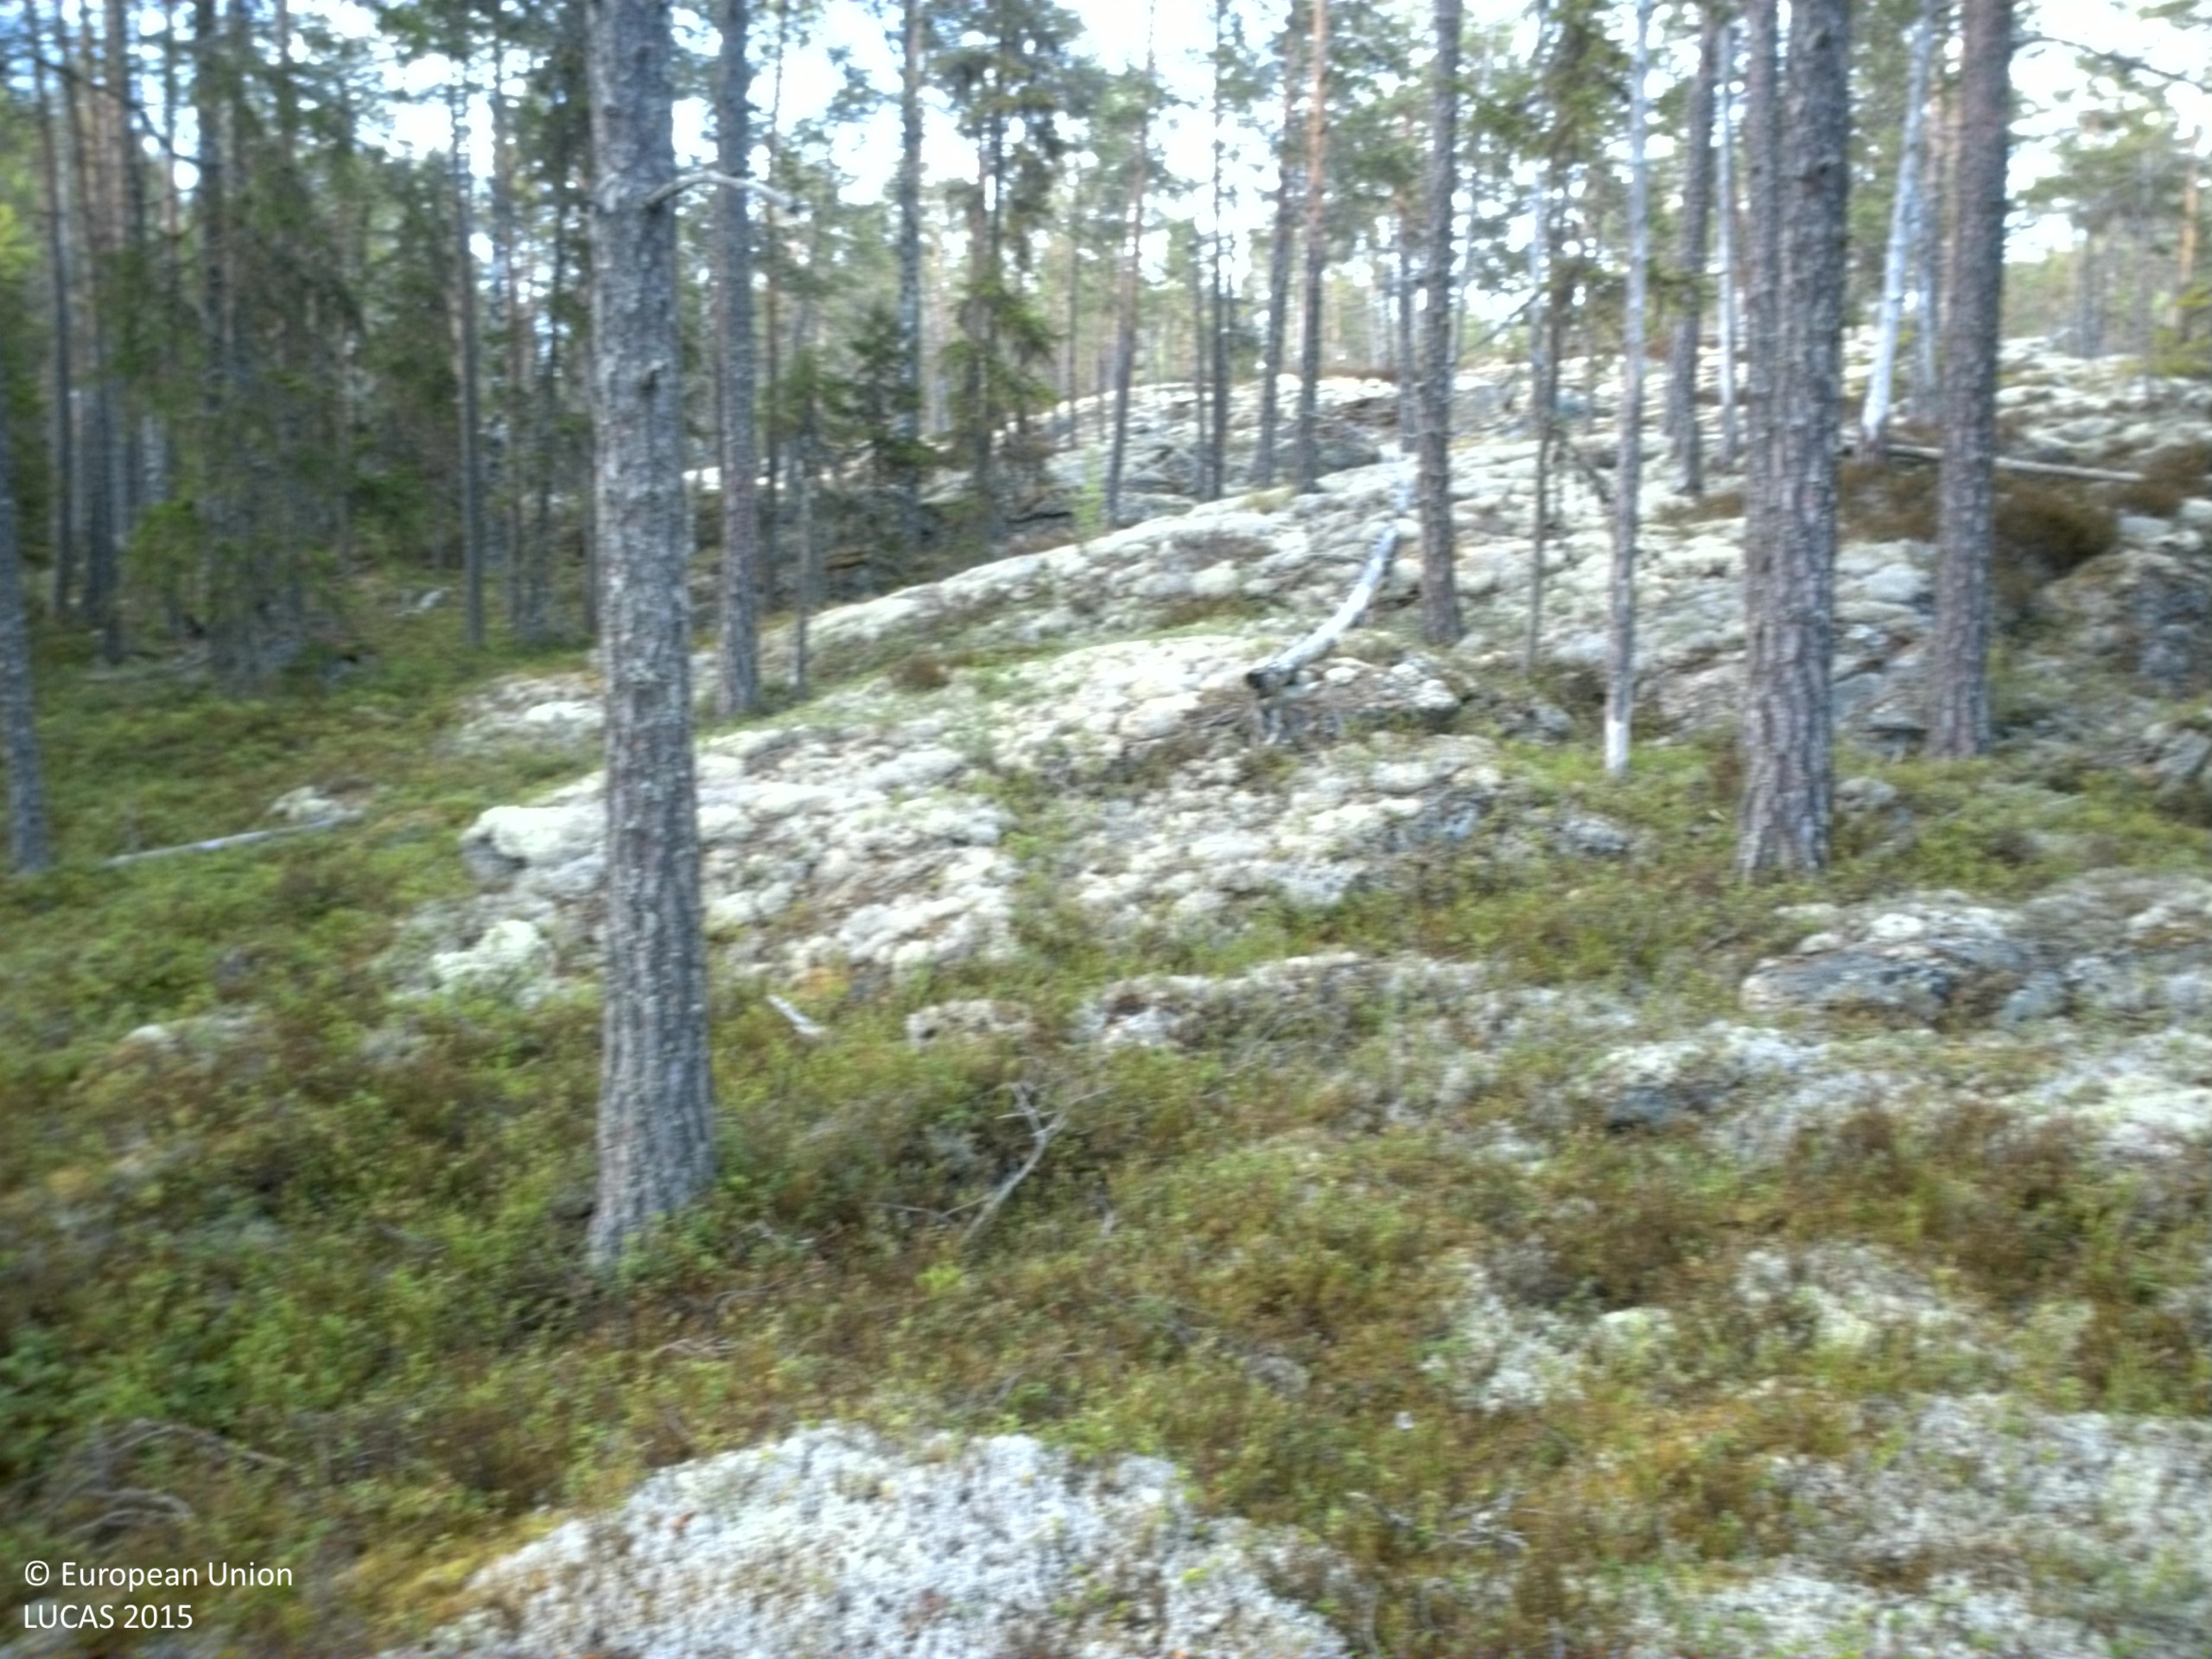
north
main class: Woodland
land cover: Pine dominated coniferous woodland
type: boreal forest
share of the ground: 25 - 50 %
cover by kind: coniferous forest trees 35 %, shrubs 30 %, lichens and mosses 30 %, consolidated bare surface 5 %
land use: Forestry
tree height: > 5 m
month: May
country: SE
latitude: 63.1170
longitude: 17.8070
